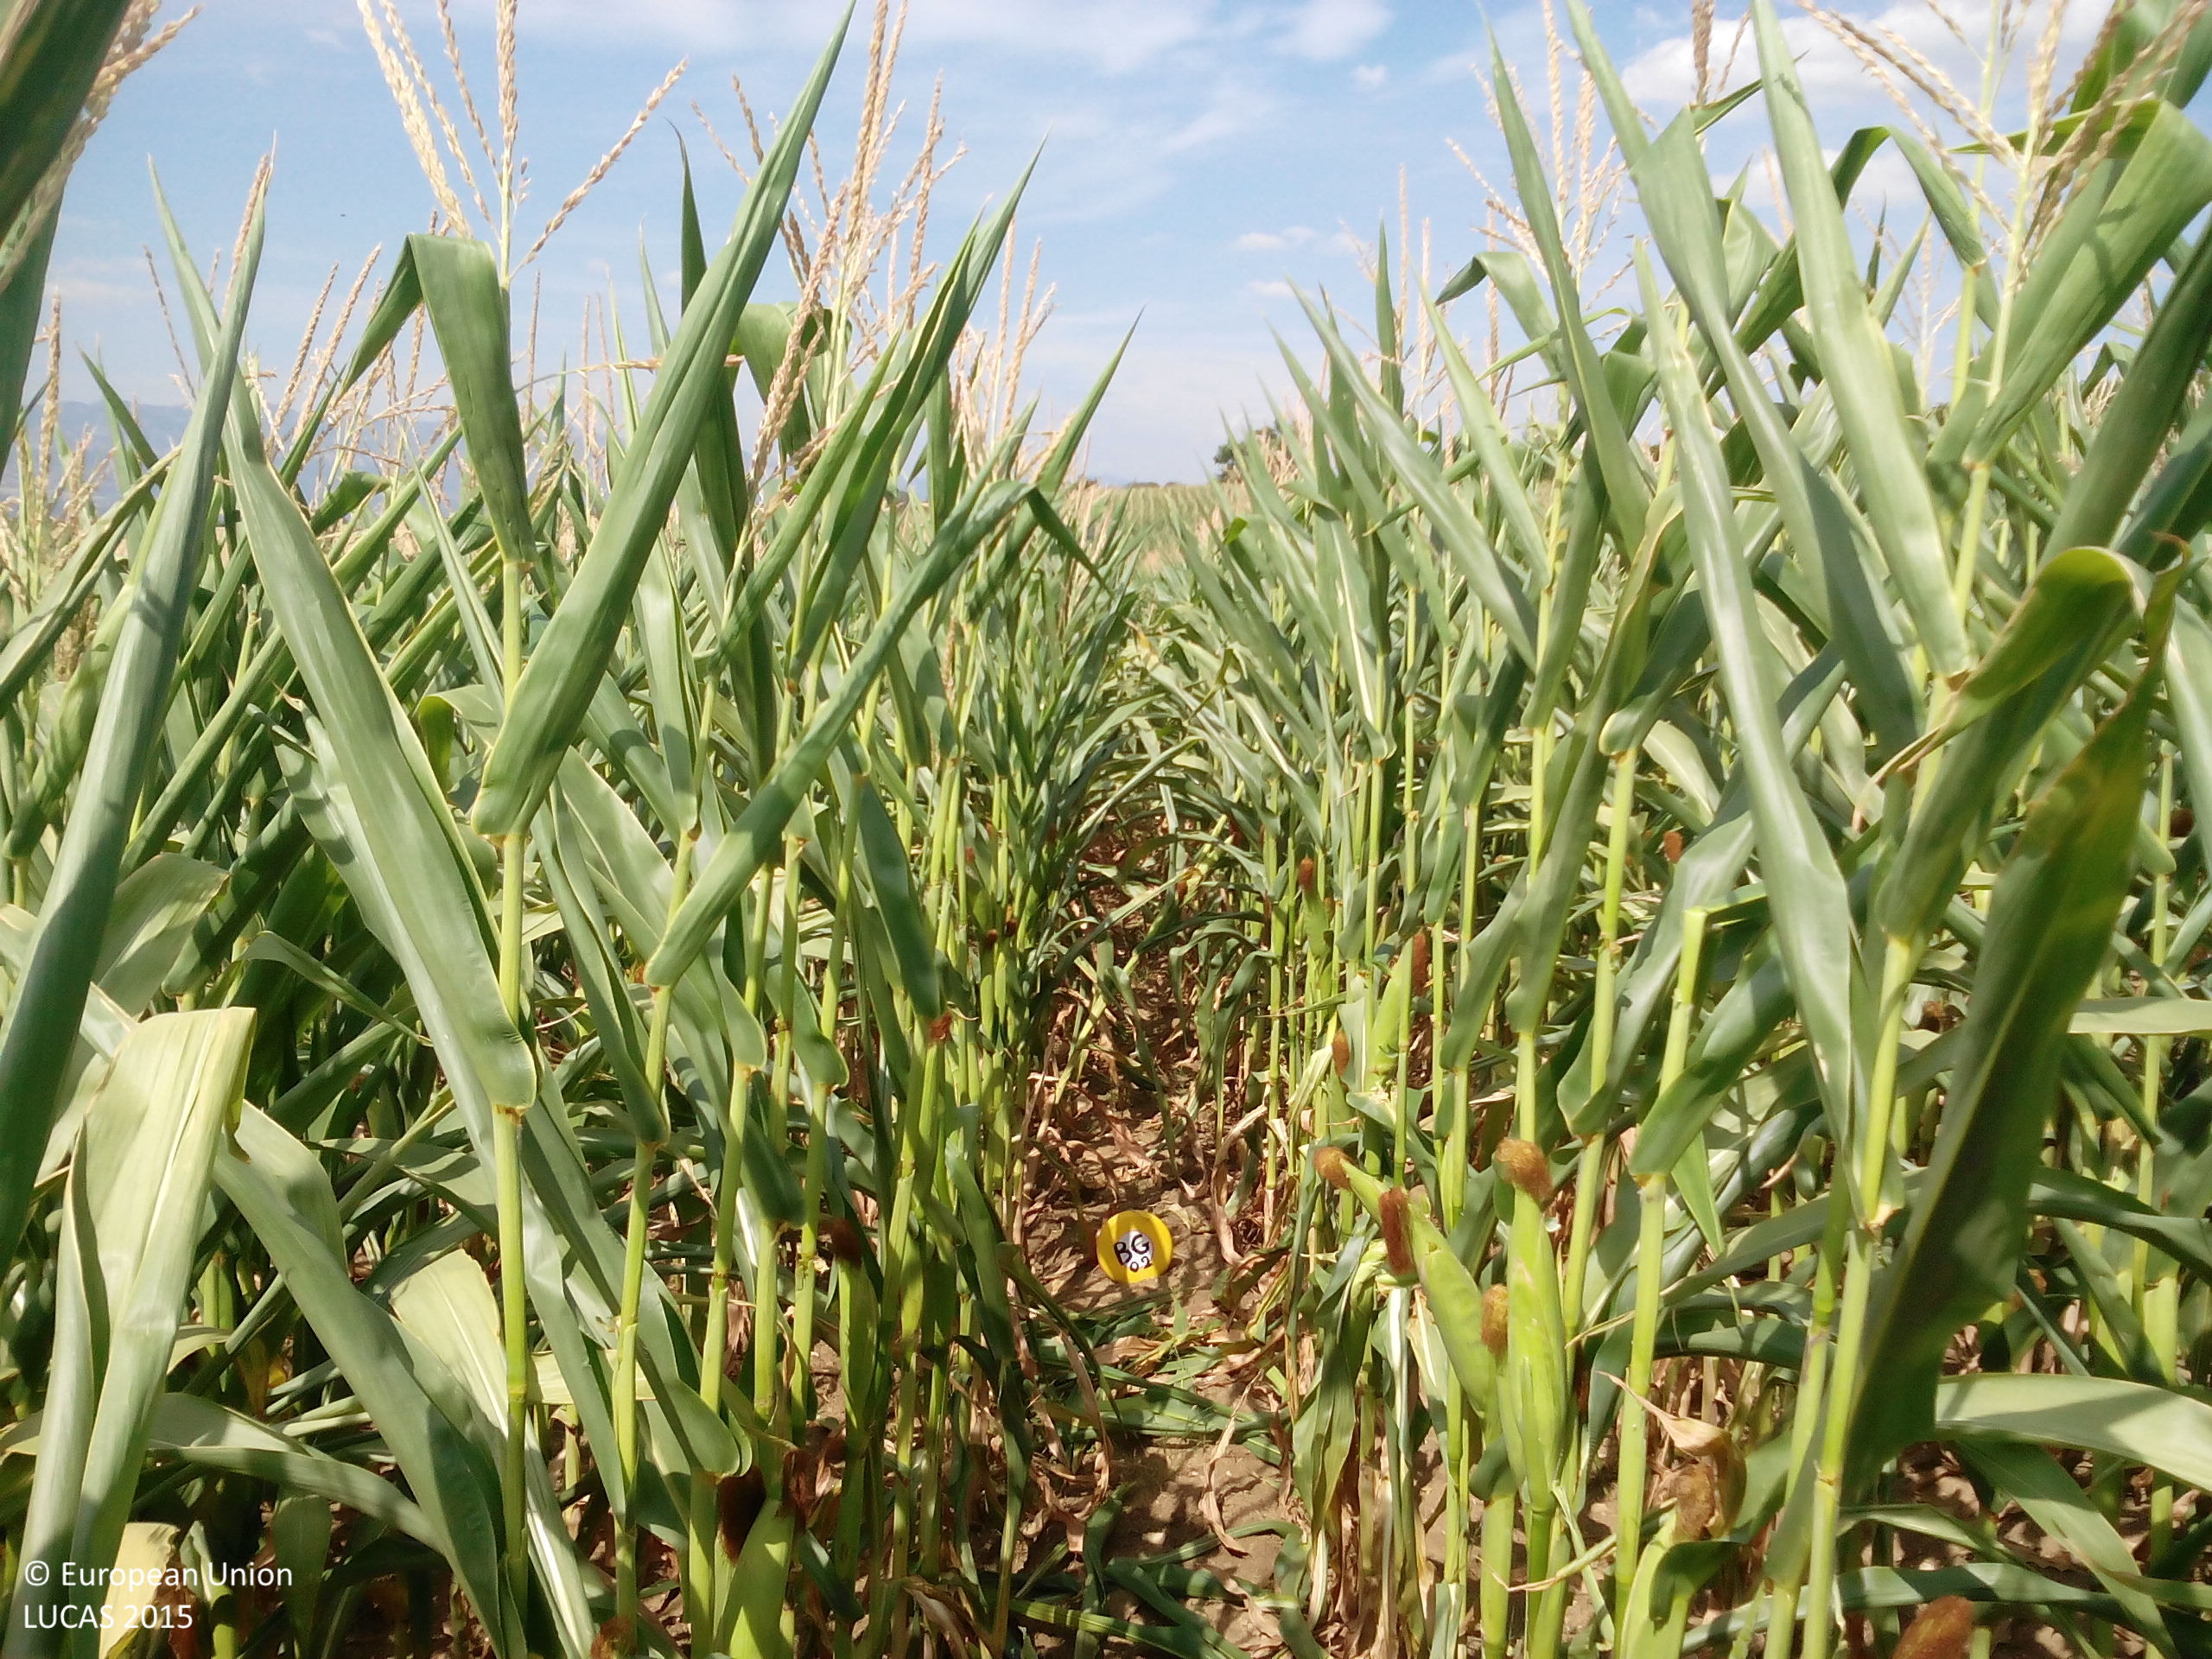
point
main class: Cropland
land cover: Maize
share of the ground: > 75 %
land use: Agriculture (excluding fallow land and kitchen gardens)
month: August
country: BG
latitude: 43.1871
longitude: 23.7900
